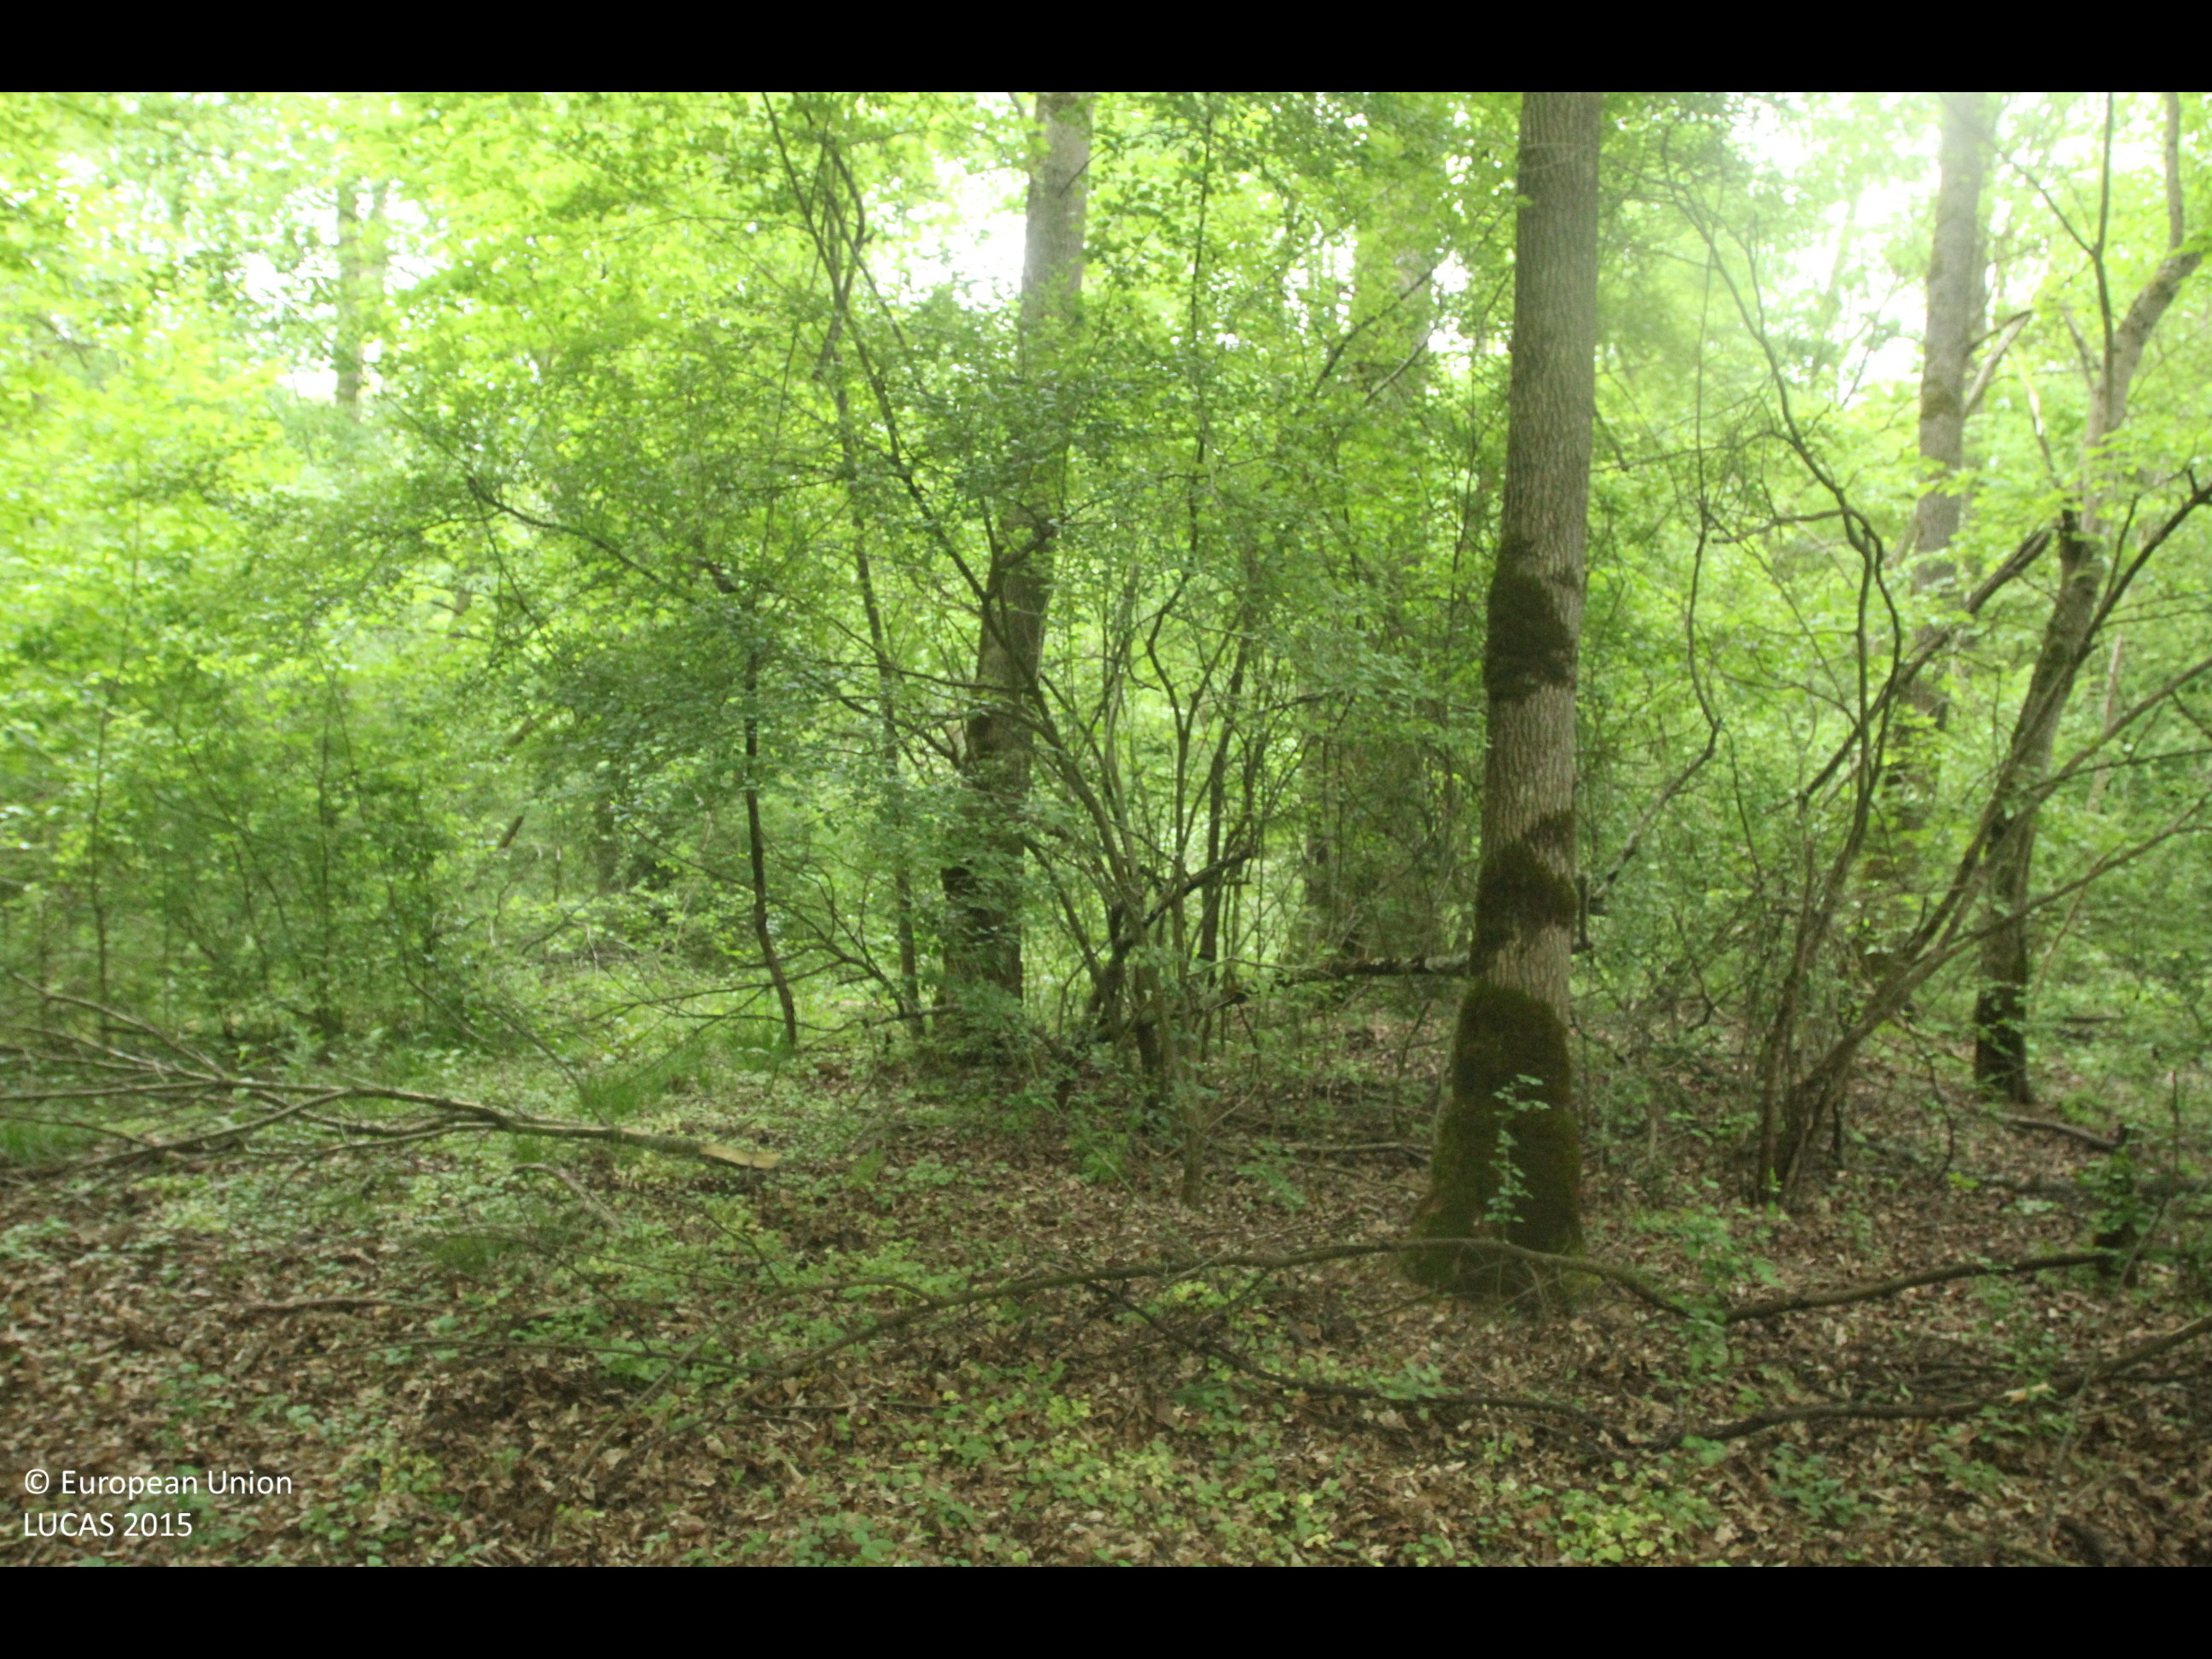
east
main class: Woodland
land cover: Broadleaved woodland
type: mesophytic deciduous forest
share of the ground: > 75 %
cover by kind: broadleaved forest trees 100 %
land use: Forestry
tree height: > 5 m
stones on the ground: < 10 %
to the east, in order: Broadleaved woodland
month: April
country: HR
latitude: 45.0103
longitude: 19.0031
